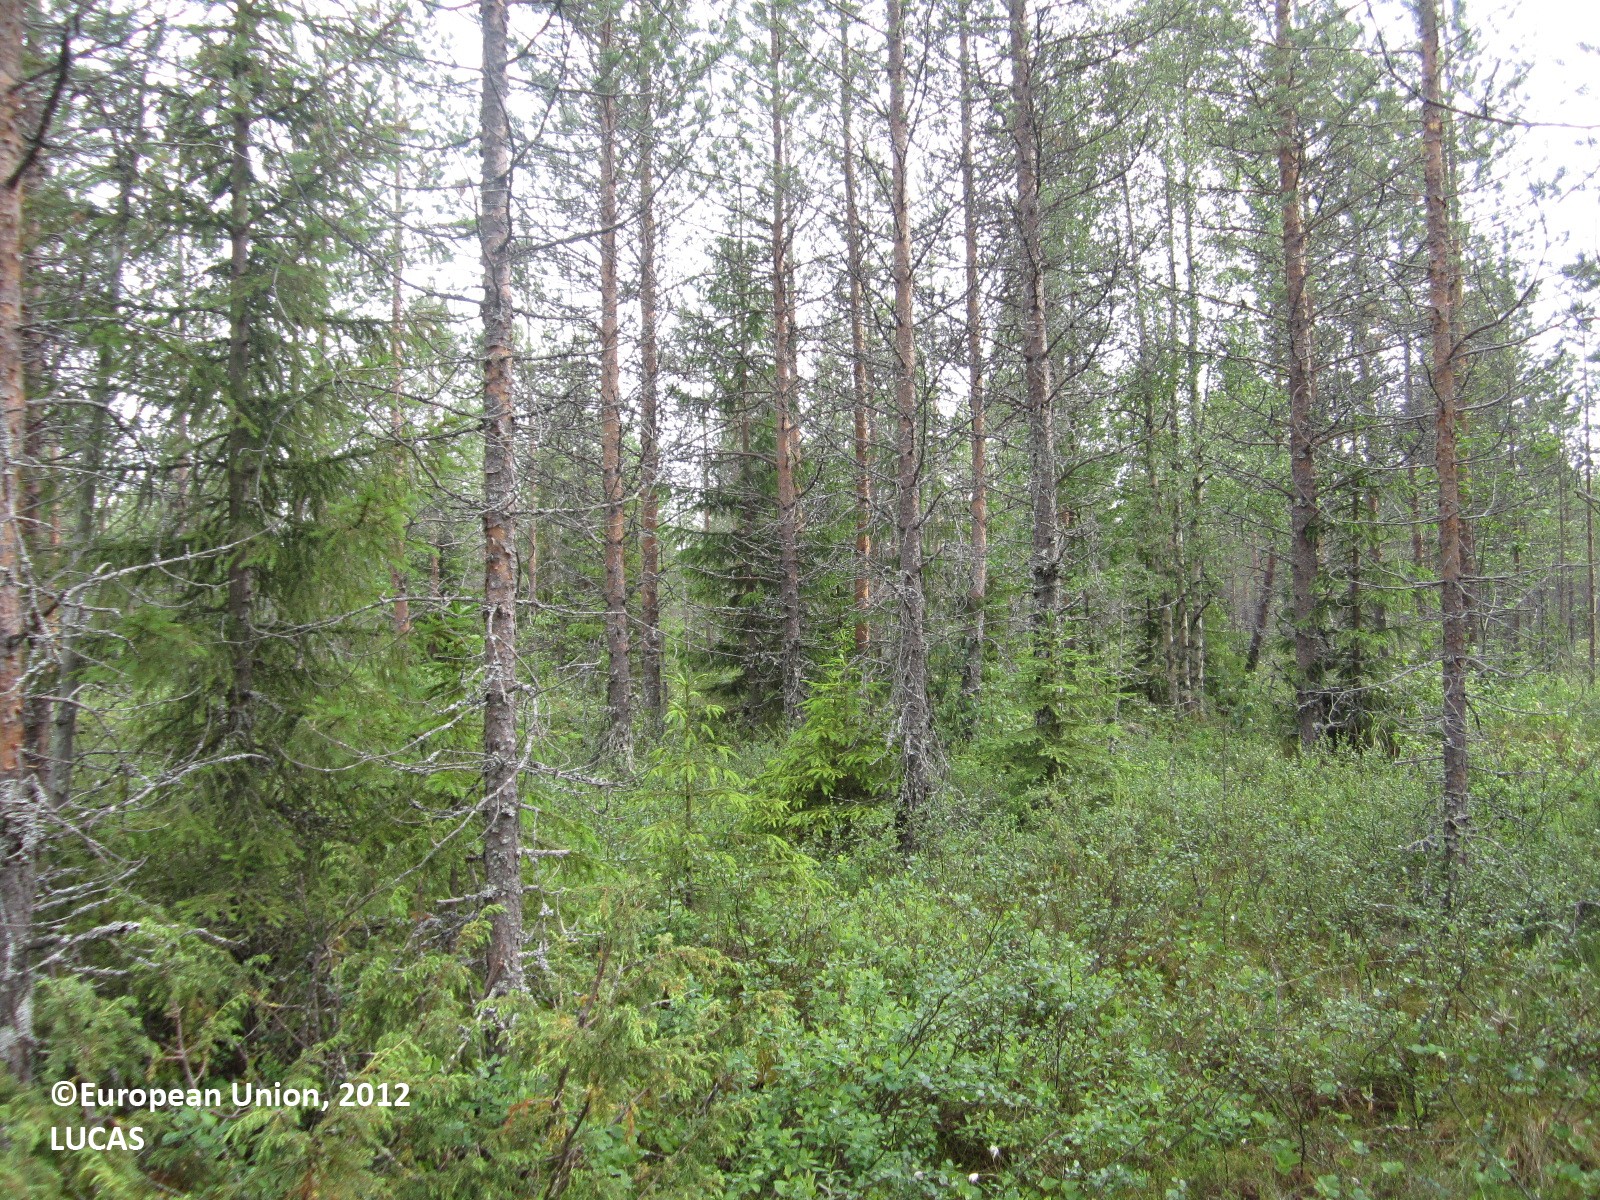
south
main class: Woodland
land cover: Pine dominated coniferous woodland
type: boreal forest
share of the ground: 50 - 75 %
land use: Forestry
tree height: > 5 m
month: June
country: FI
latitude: 64.4846
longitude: 29.7618
